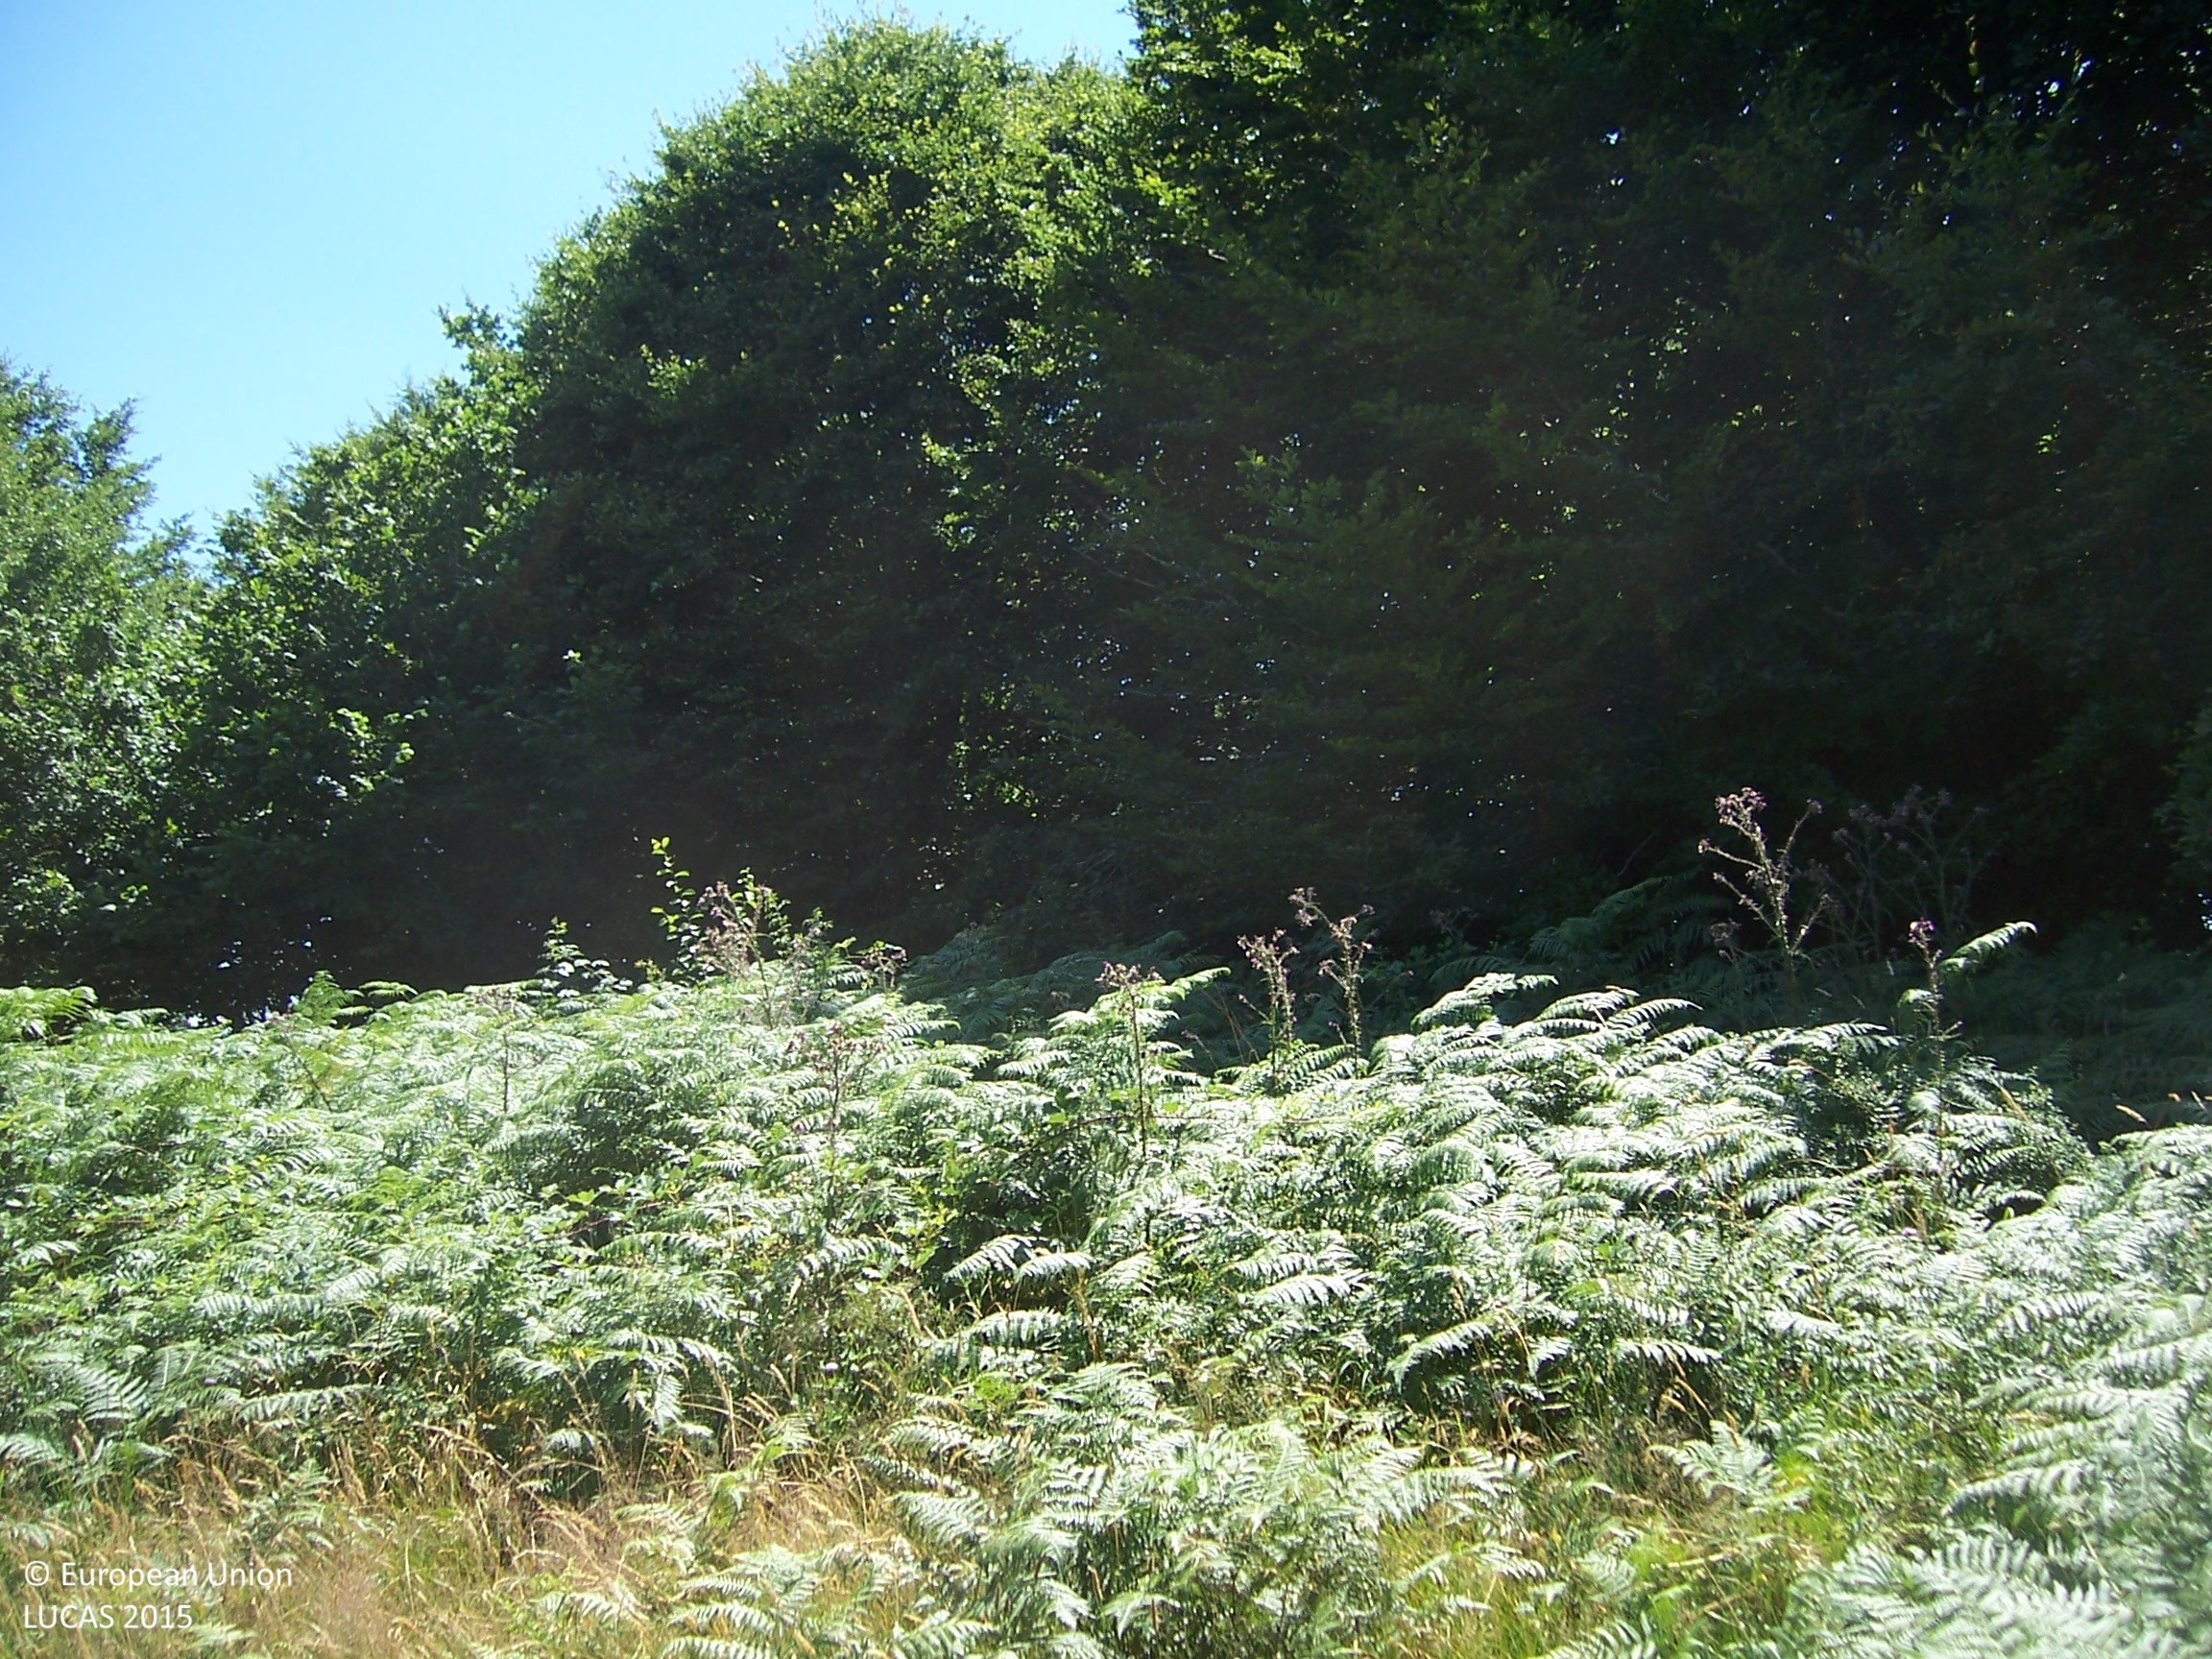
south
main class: Woodland
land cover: Broadleaved woodland
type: mountainous beech forest
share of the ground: > 75 %
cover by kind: broadleaved forest trees 100 %
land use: Forestry
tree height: > 5 m
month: July
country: ES
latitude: 42.8879
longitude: -1.1900
